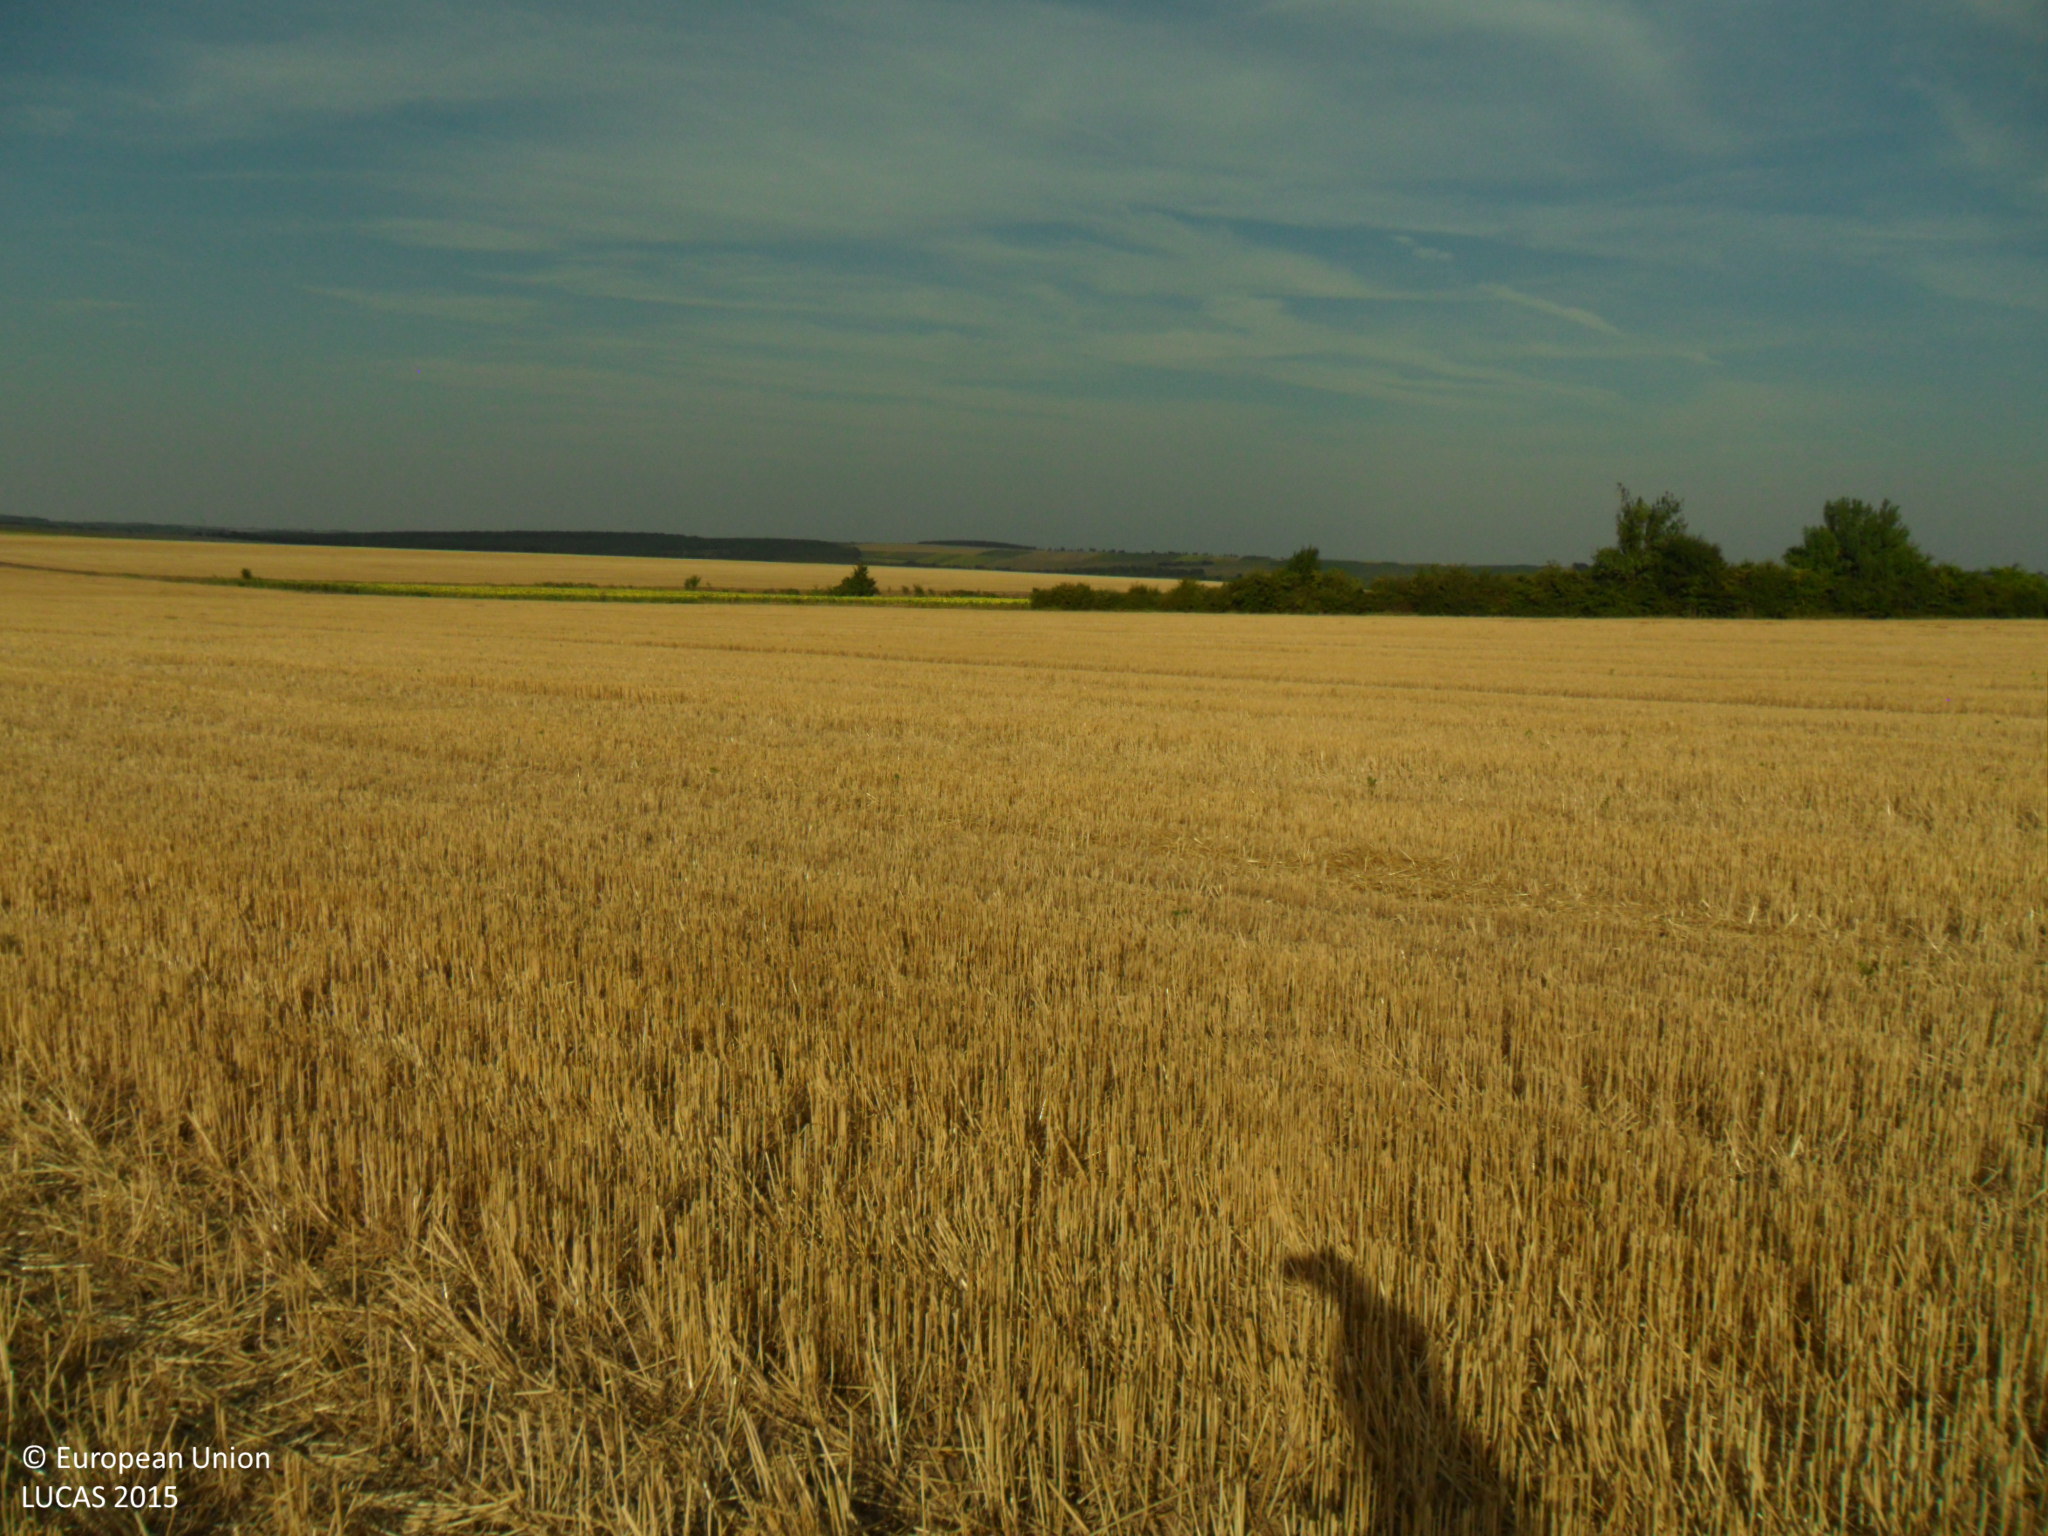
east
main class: Cropland
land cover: Common wheat
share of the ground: 25 - 50 %
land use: Agriculture (excluding fallow land and kitchen gardens)
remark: Harvested field
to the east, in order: Common wheat; Grass margins; Tracks; Shrubland with sparse tree cover; Sunflower
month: August
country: BG
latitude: 43.6510
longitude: 27.1207
